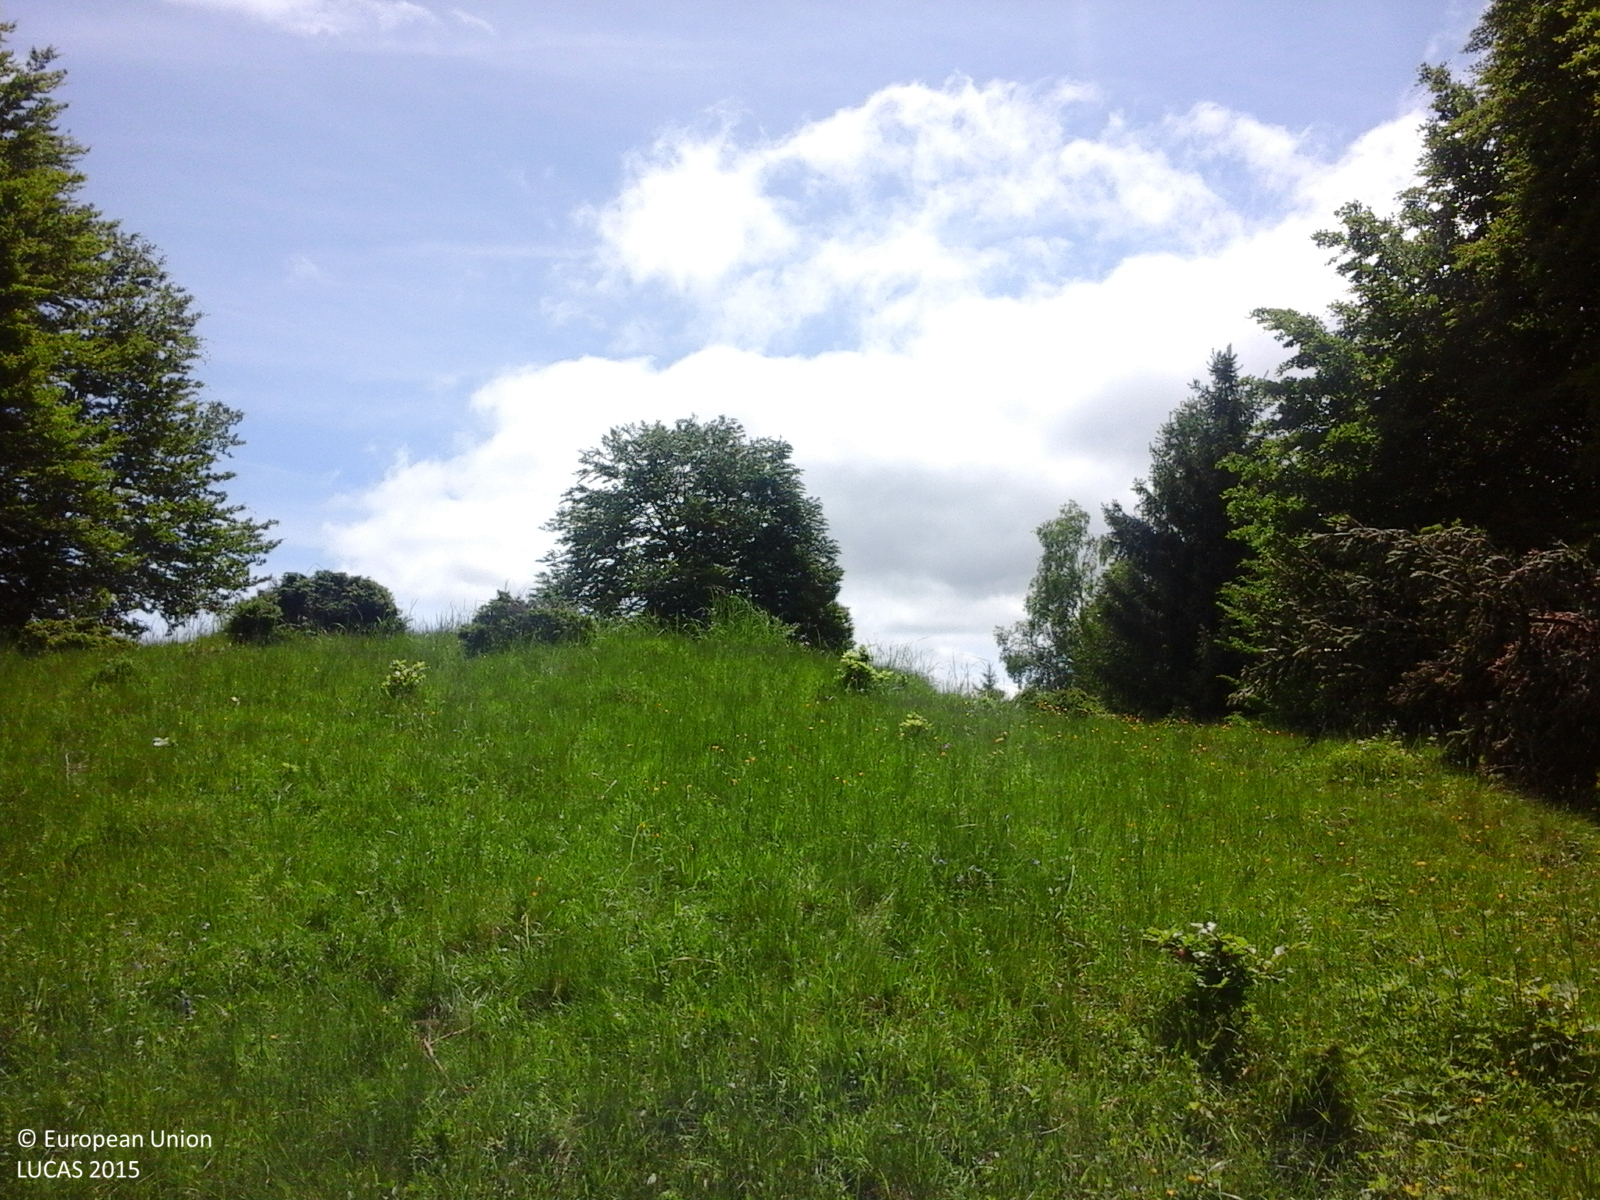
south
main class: Grassland
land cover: Grassland with sparse tree/shrub cover
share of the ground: > 75 %
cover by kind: herbaceous plants 90 %, broadleaved forest trees 5 %, shrubs 5 %
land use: Forestry
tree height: > 5 m
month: May
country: RO
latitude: 45.3974
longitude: 26.0951
